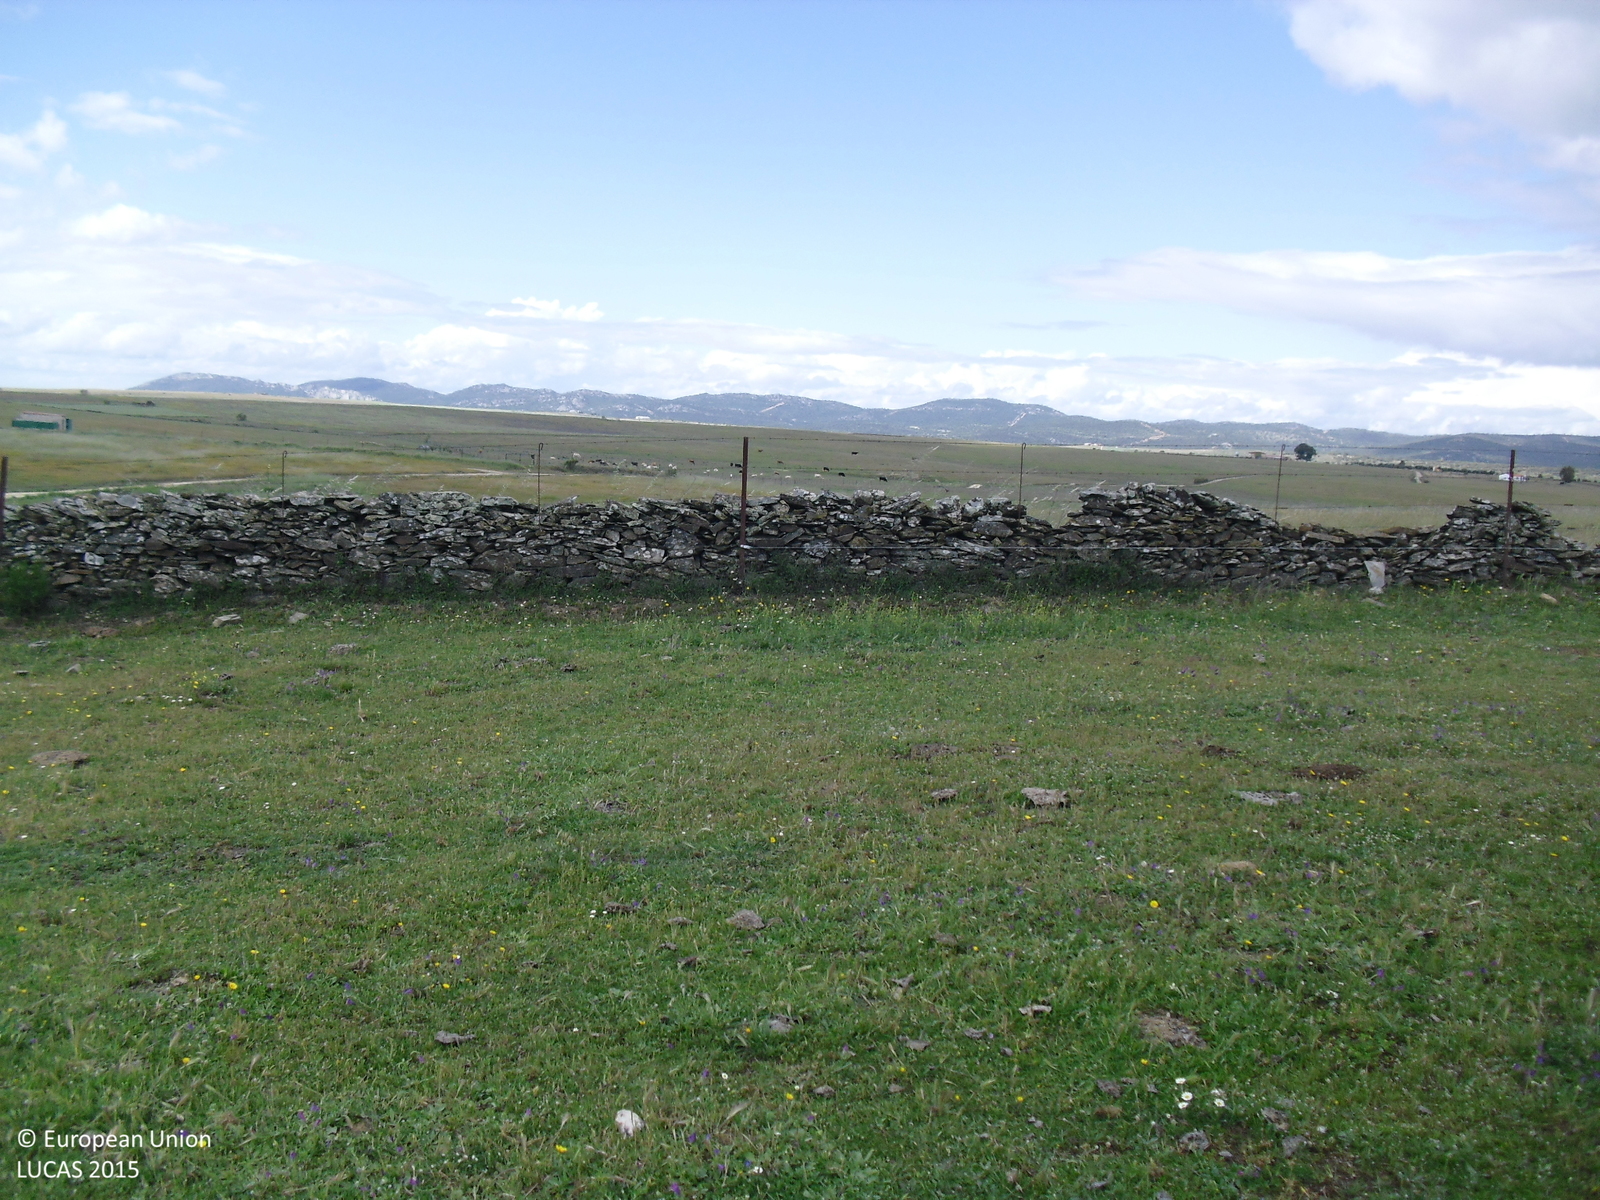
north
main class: Grassland
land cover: Grassland without tree/shrub cover
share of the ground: > 75 %
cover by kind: herbaceous plants 100 %
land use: Agriculture (excluding fallow land and kitchen gardens)
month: April
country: ES
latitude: 39.3920
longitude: -7.1395
